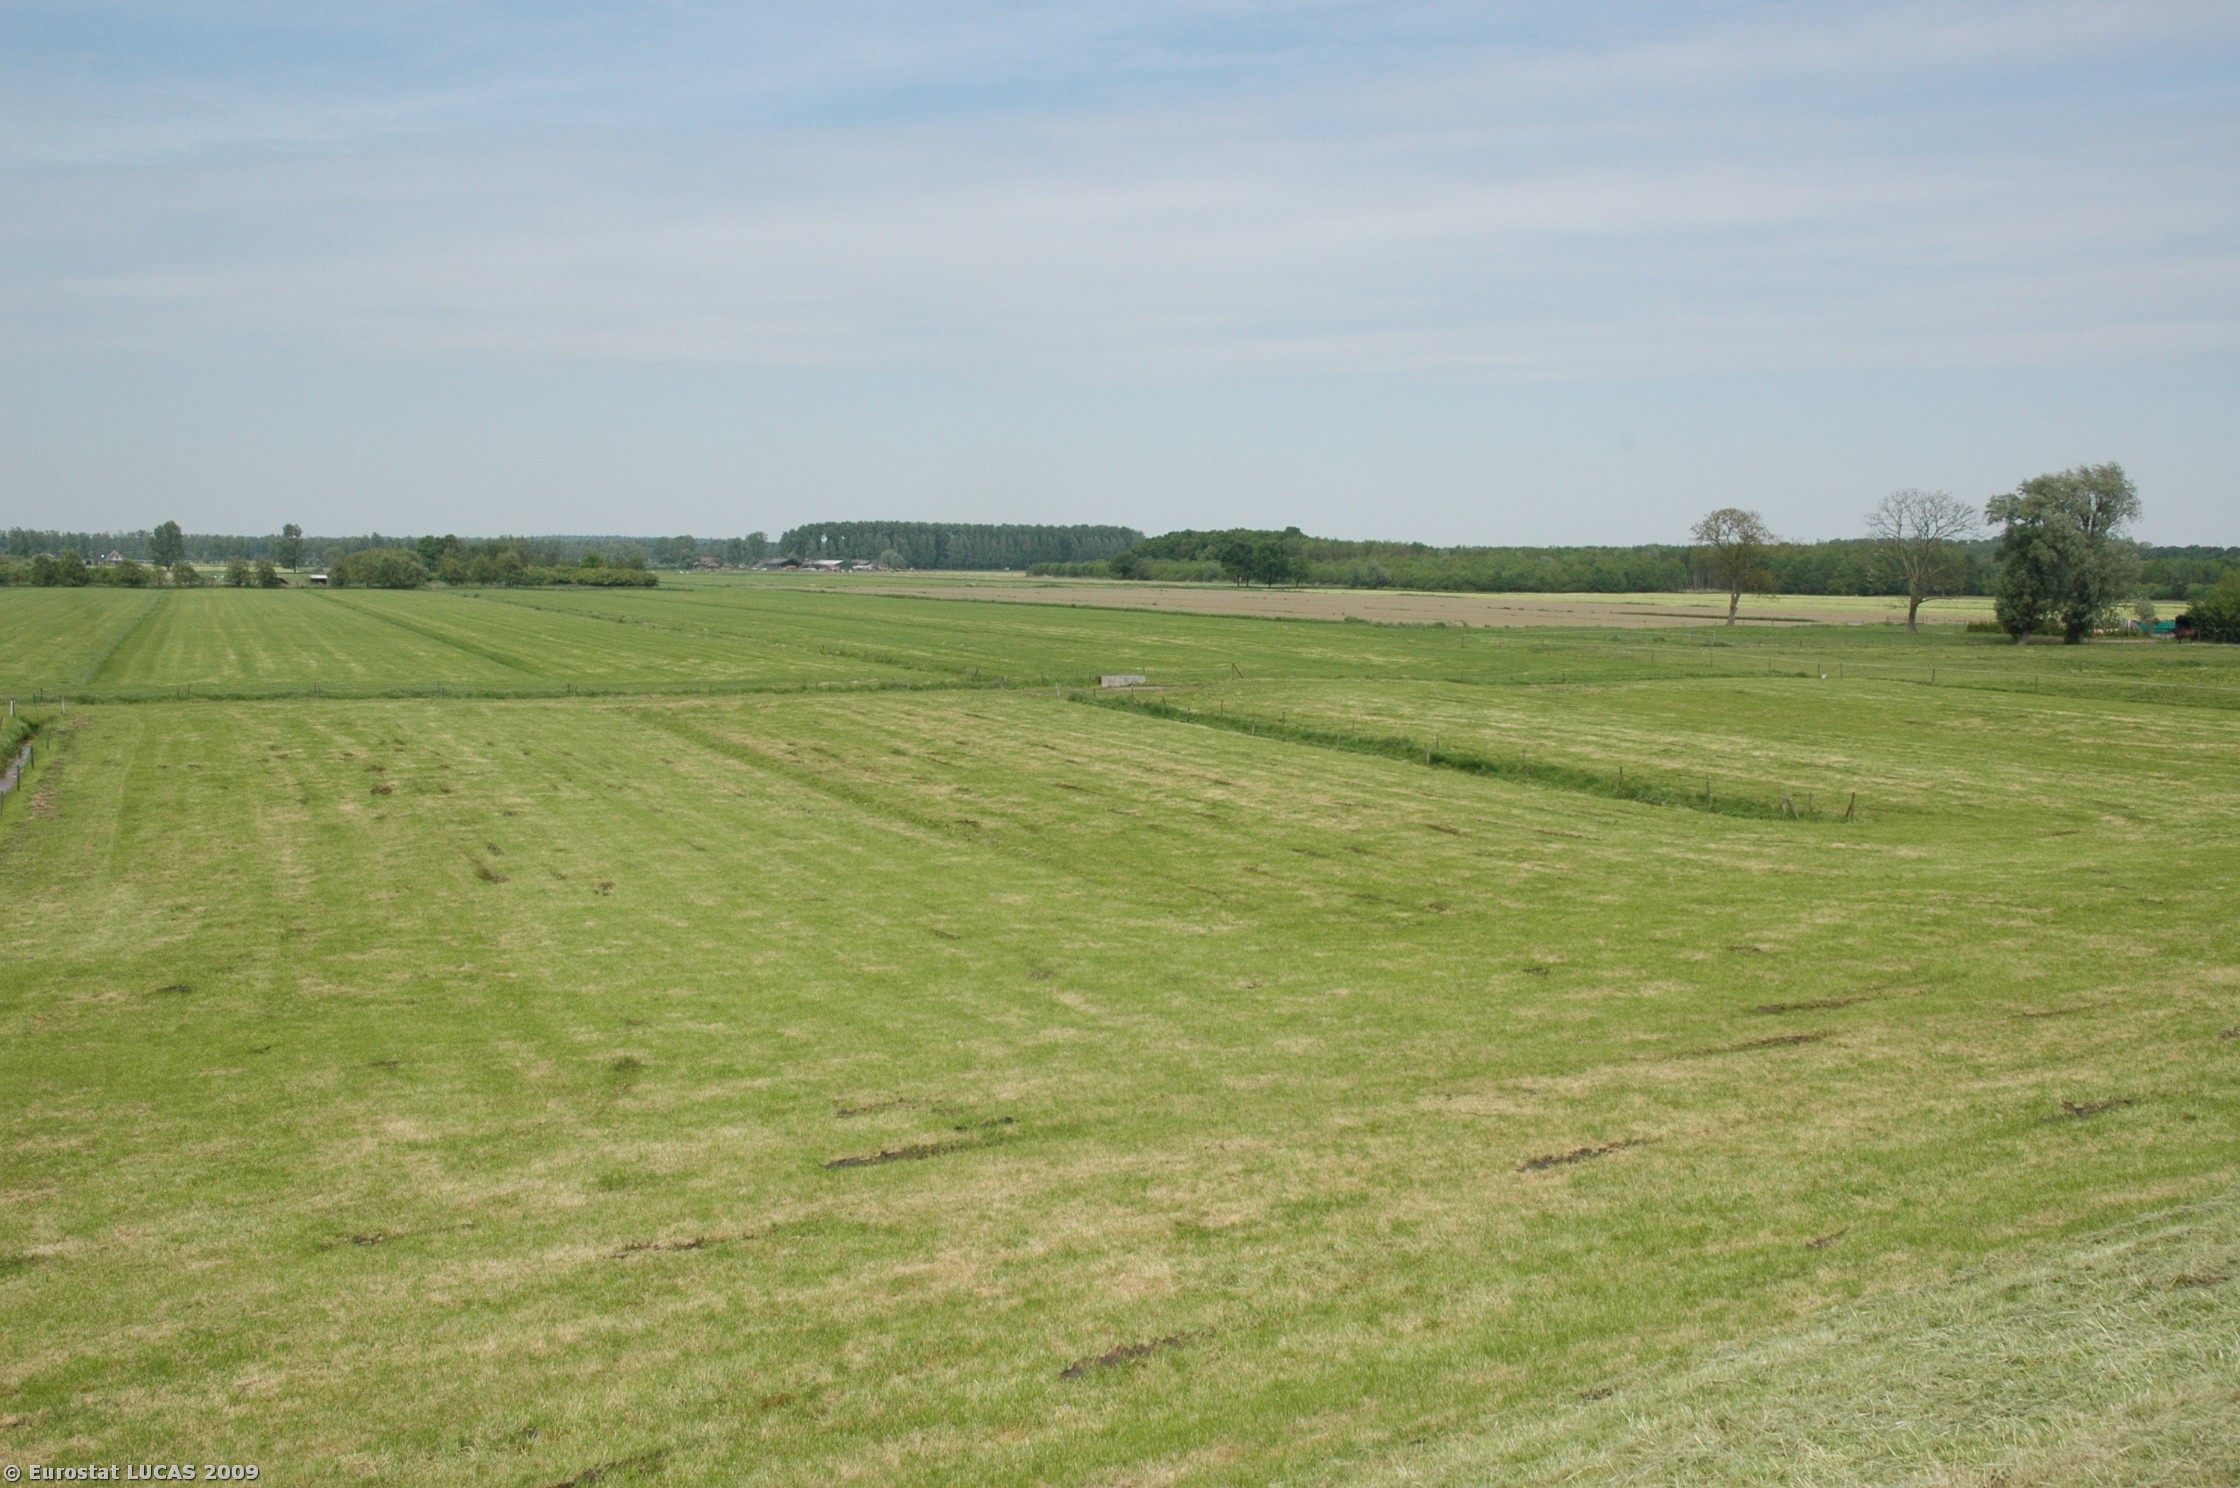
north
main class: Grassland
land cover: Grassland without tree/shrub cover
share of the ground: > 75 %
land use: Agriculture (excluding fallow land and kitchen gardens)
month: May
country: NL
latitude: 51.9828
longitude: 5.4116
